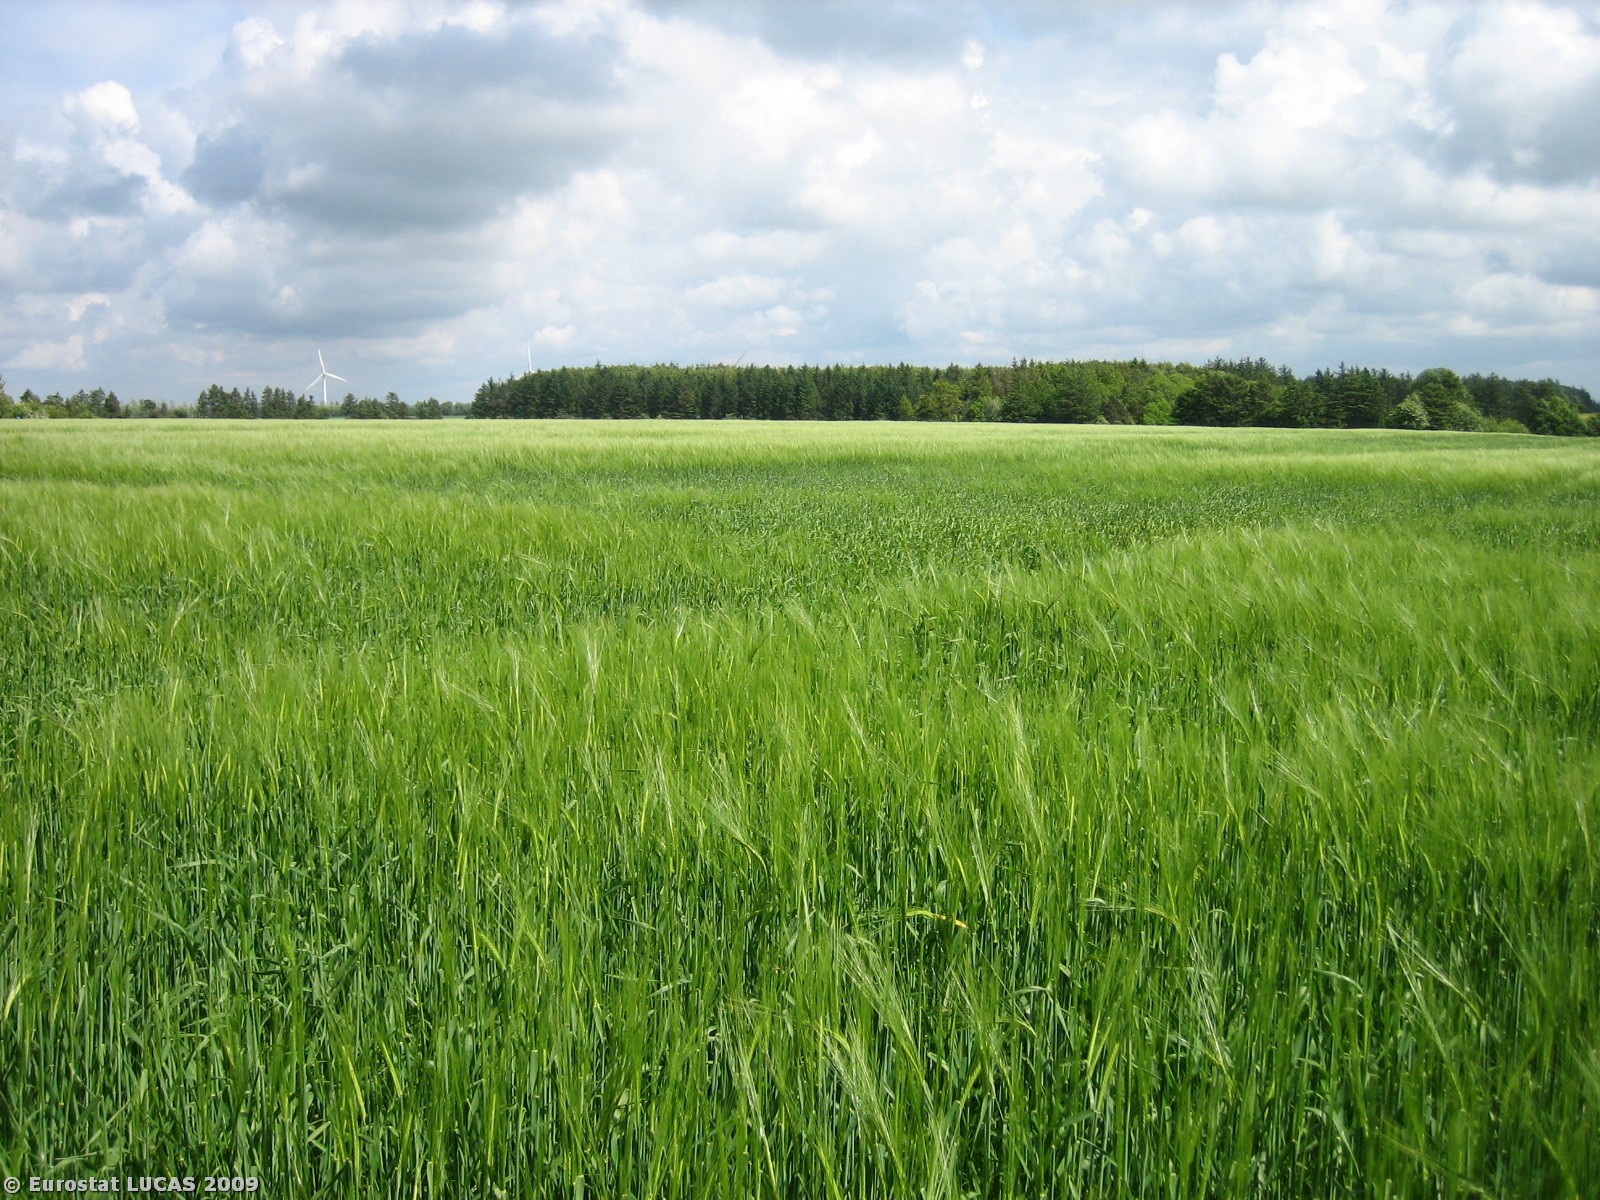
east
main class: Cropland
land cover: Barley
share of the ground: > 75 %
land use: Agriculture (excluding fallow land and kitchen gardens)
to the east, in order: Barley; Mixed woodland; Tracks; Barley
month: May
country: DK
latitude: 55.9661
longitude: 8.7677
